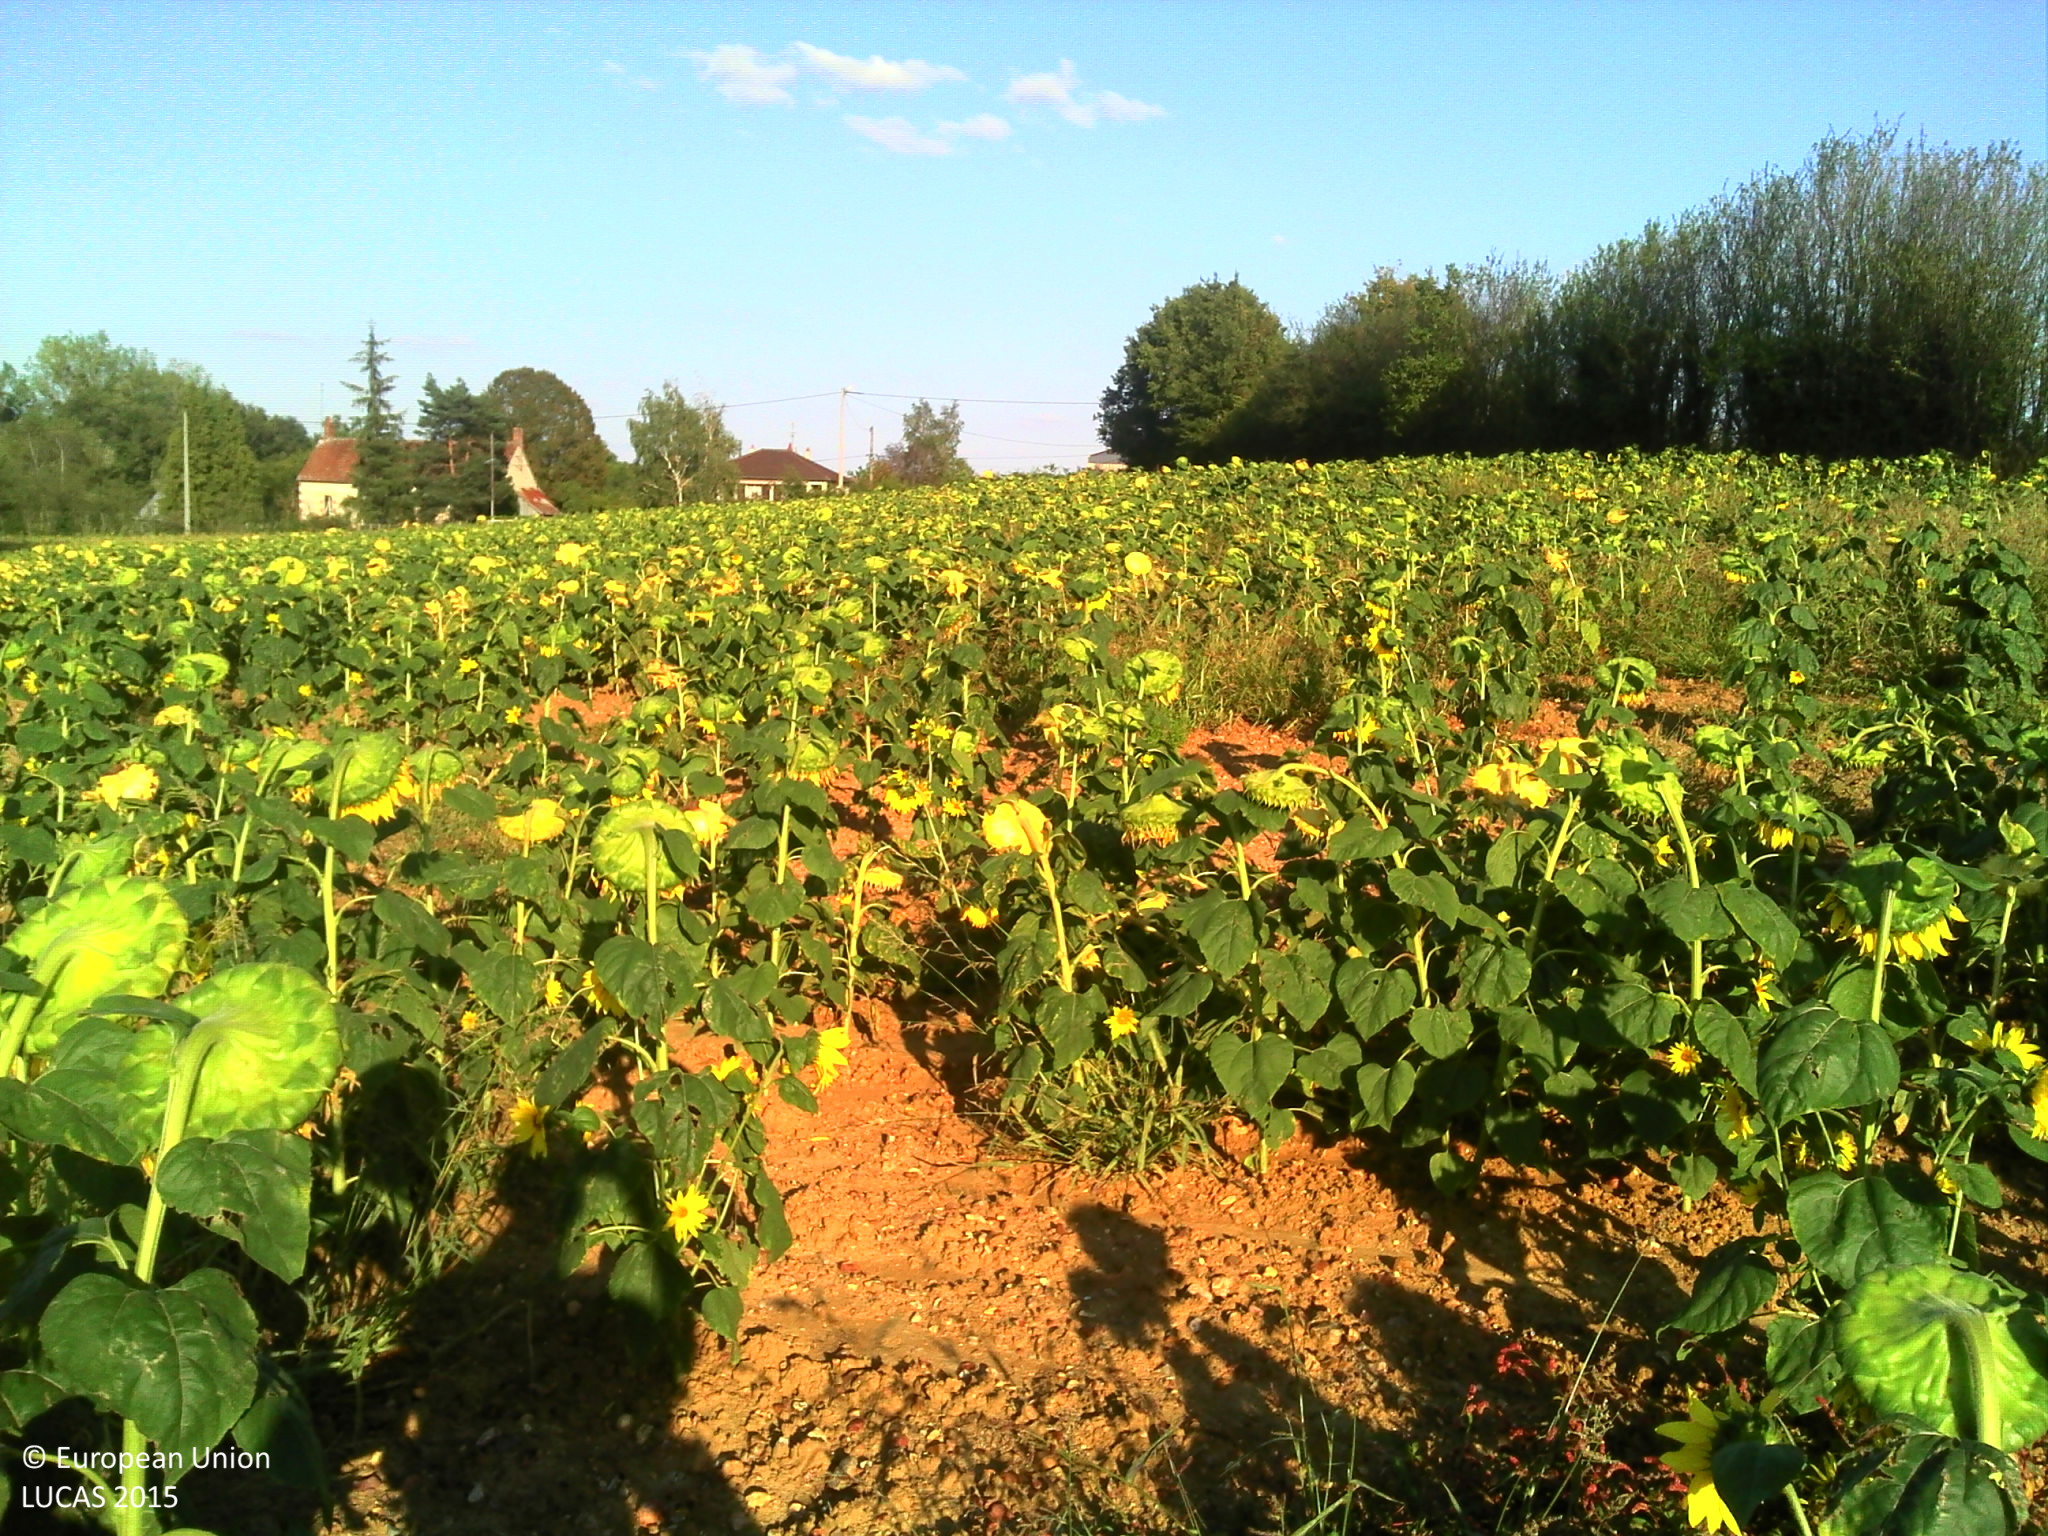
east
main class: Cropland
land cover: Sunflower
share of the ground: > 75 %
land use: Agriculture (excluding fallow land and kitchen gardens)
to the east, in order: Sunflower; Grass margins; Managed hedges; Fences; Electric lines; Ditches and canals; Grass margins; Paved roads, cycling and walking lanes; Grass margins; Grassland without tree/shrub cover; Artificial constructions in urban areas; Grassland without tree/shrub cover
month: September
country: FR
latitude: 47.0442
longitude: 1.4982
